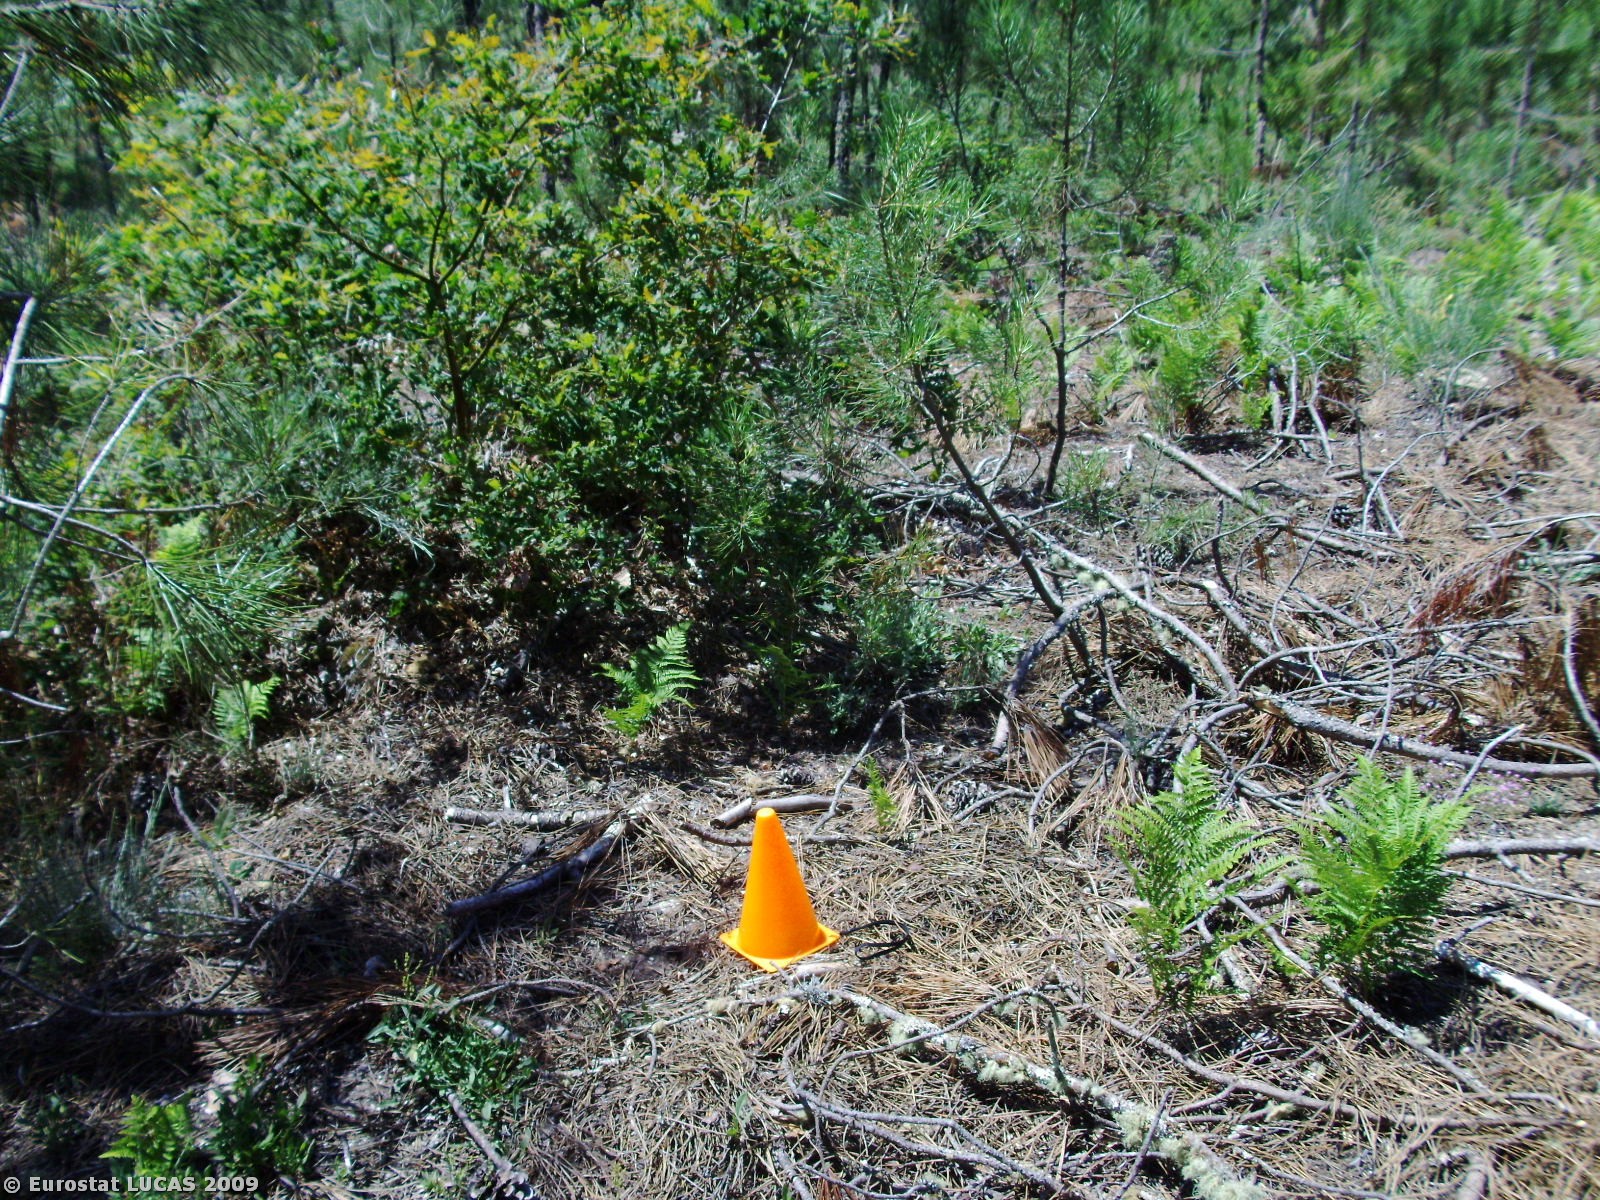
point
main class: Woodland
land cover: Coniferous woodland
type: coniferous forest of the mediterranean region
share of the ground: 50 - 75 %
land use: Forestry
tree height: > 5 m
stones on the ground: < 10 %
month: July
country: PT
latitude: 40.8563
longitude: -7.7150
